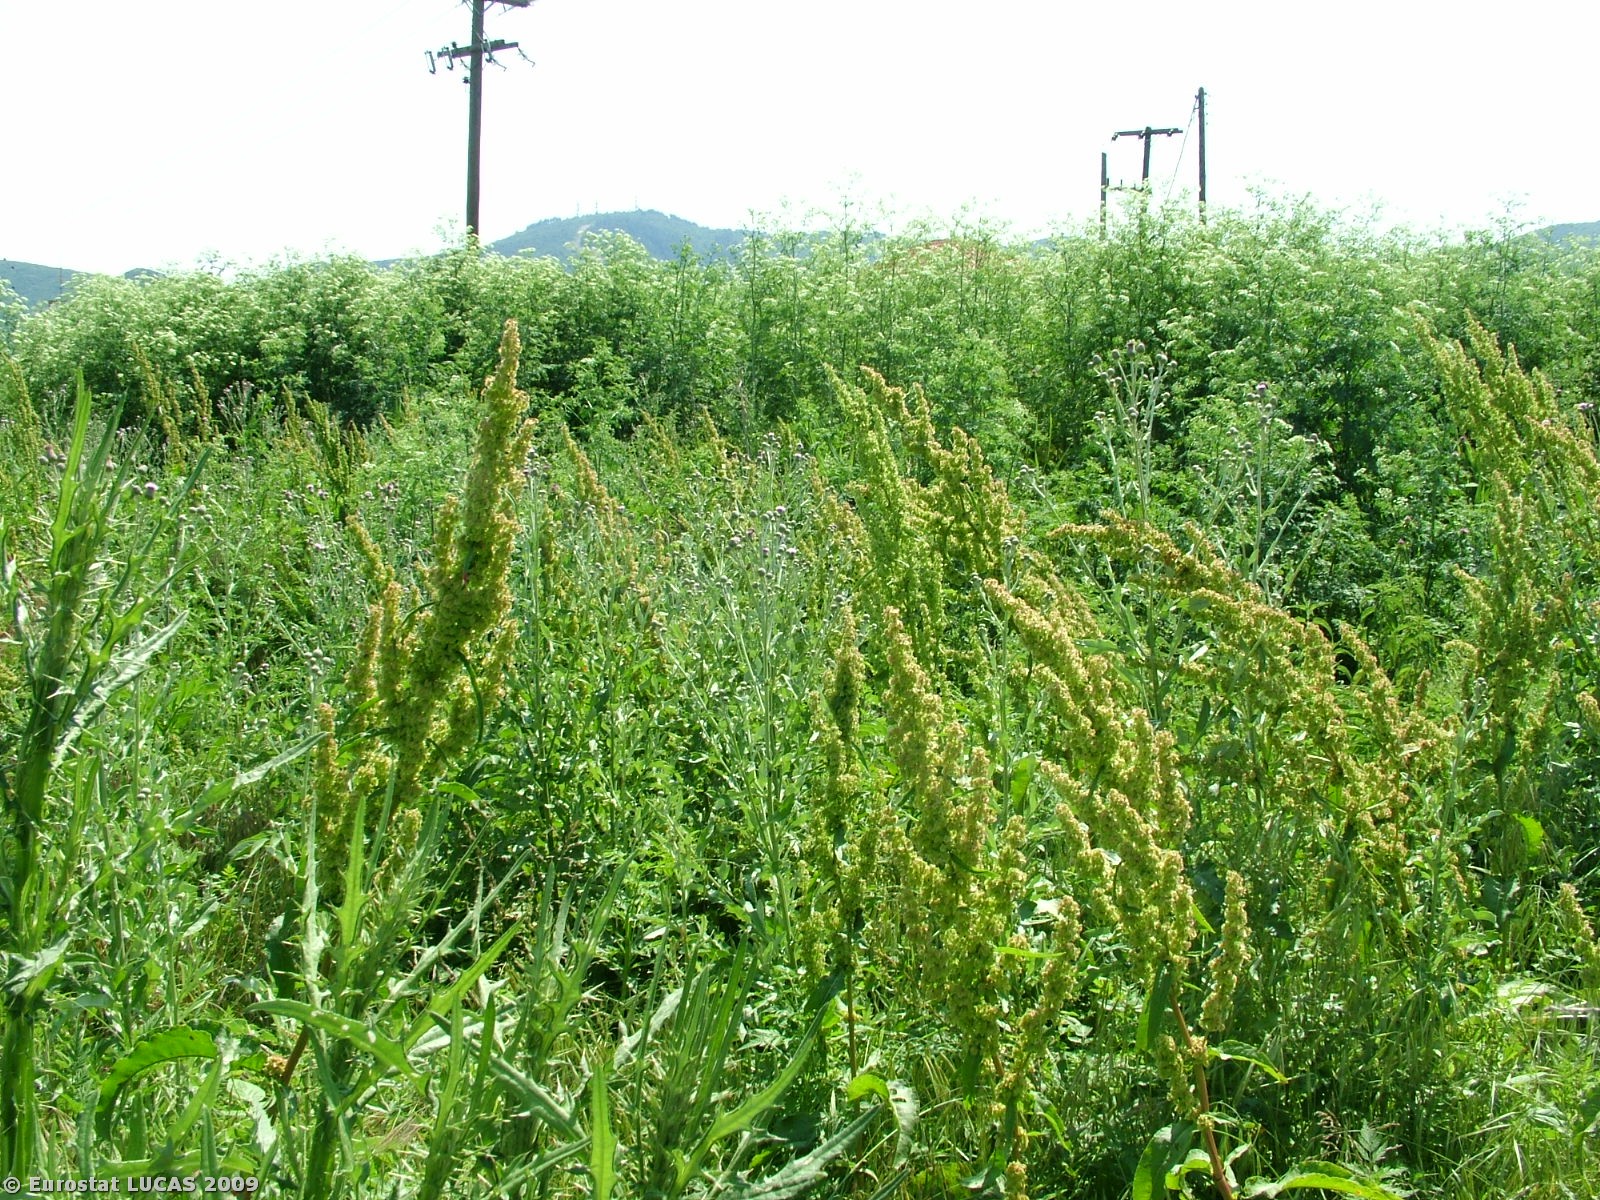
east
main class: Grassland
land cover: Grassland with sparse tree/shrub cover
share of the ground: > 75 %
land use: Unused
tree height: < 5 m
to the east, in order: Grassland with sparse tree/shrub cover; Ditches and canals; Grassland without tree/shrub cover; Electric lines; Fences; Artificial constructions in urban areas; Fences; Electric lines; Barley; Grass margins; Artificial constructions in urban areas; Grass margins; Maize; Ditches and canals; Fences; Common wheat
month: May
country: GR
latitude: 40.9348
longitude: 24.3172
